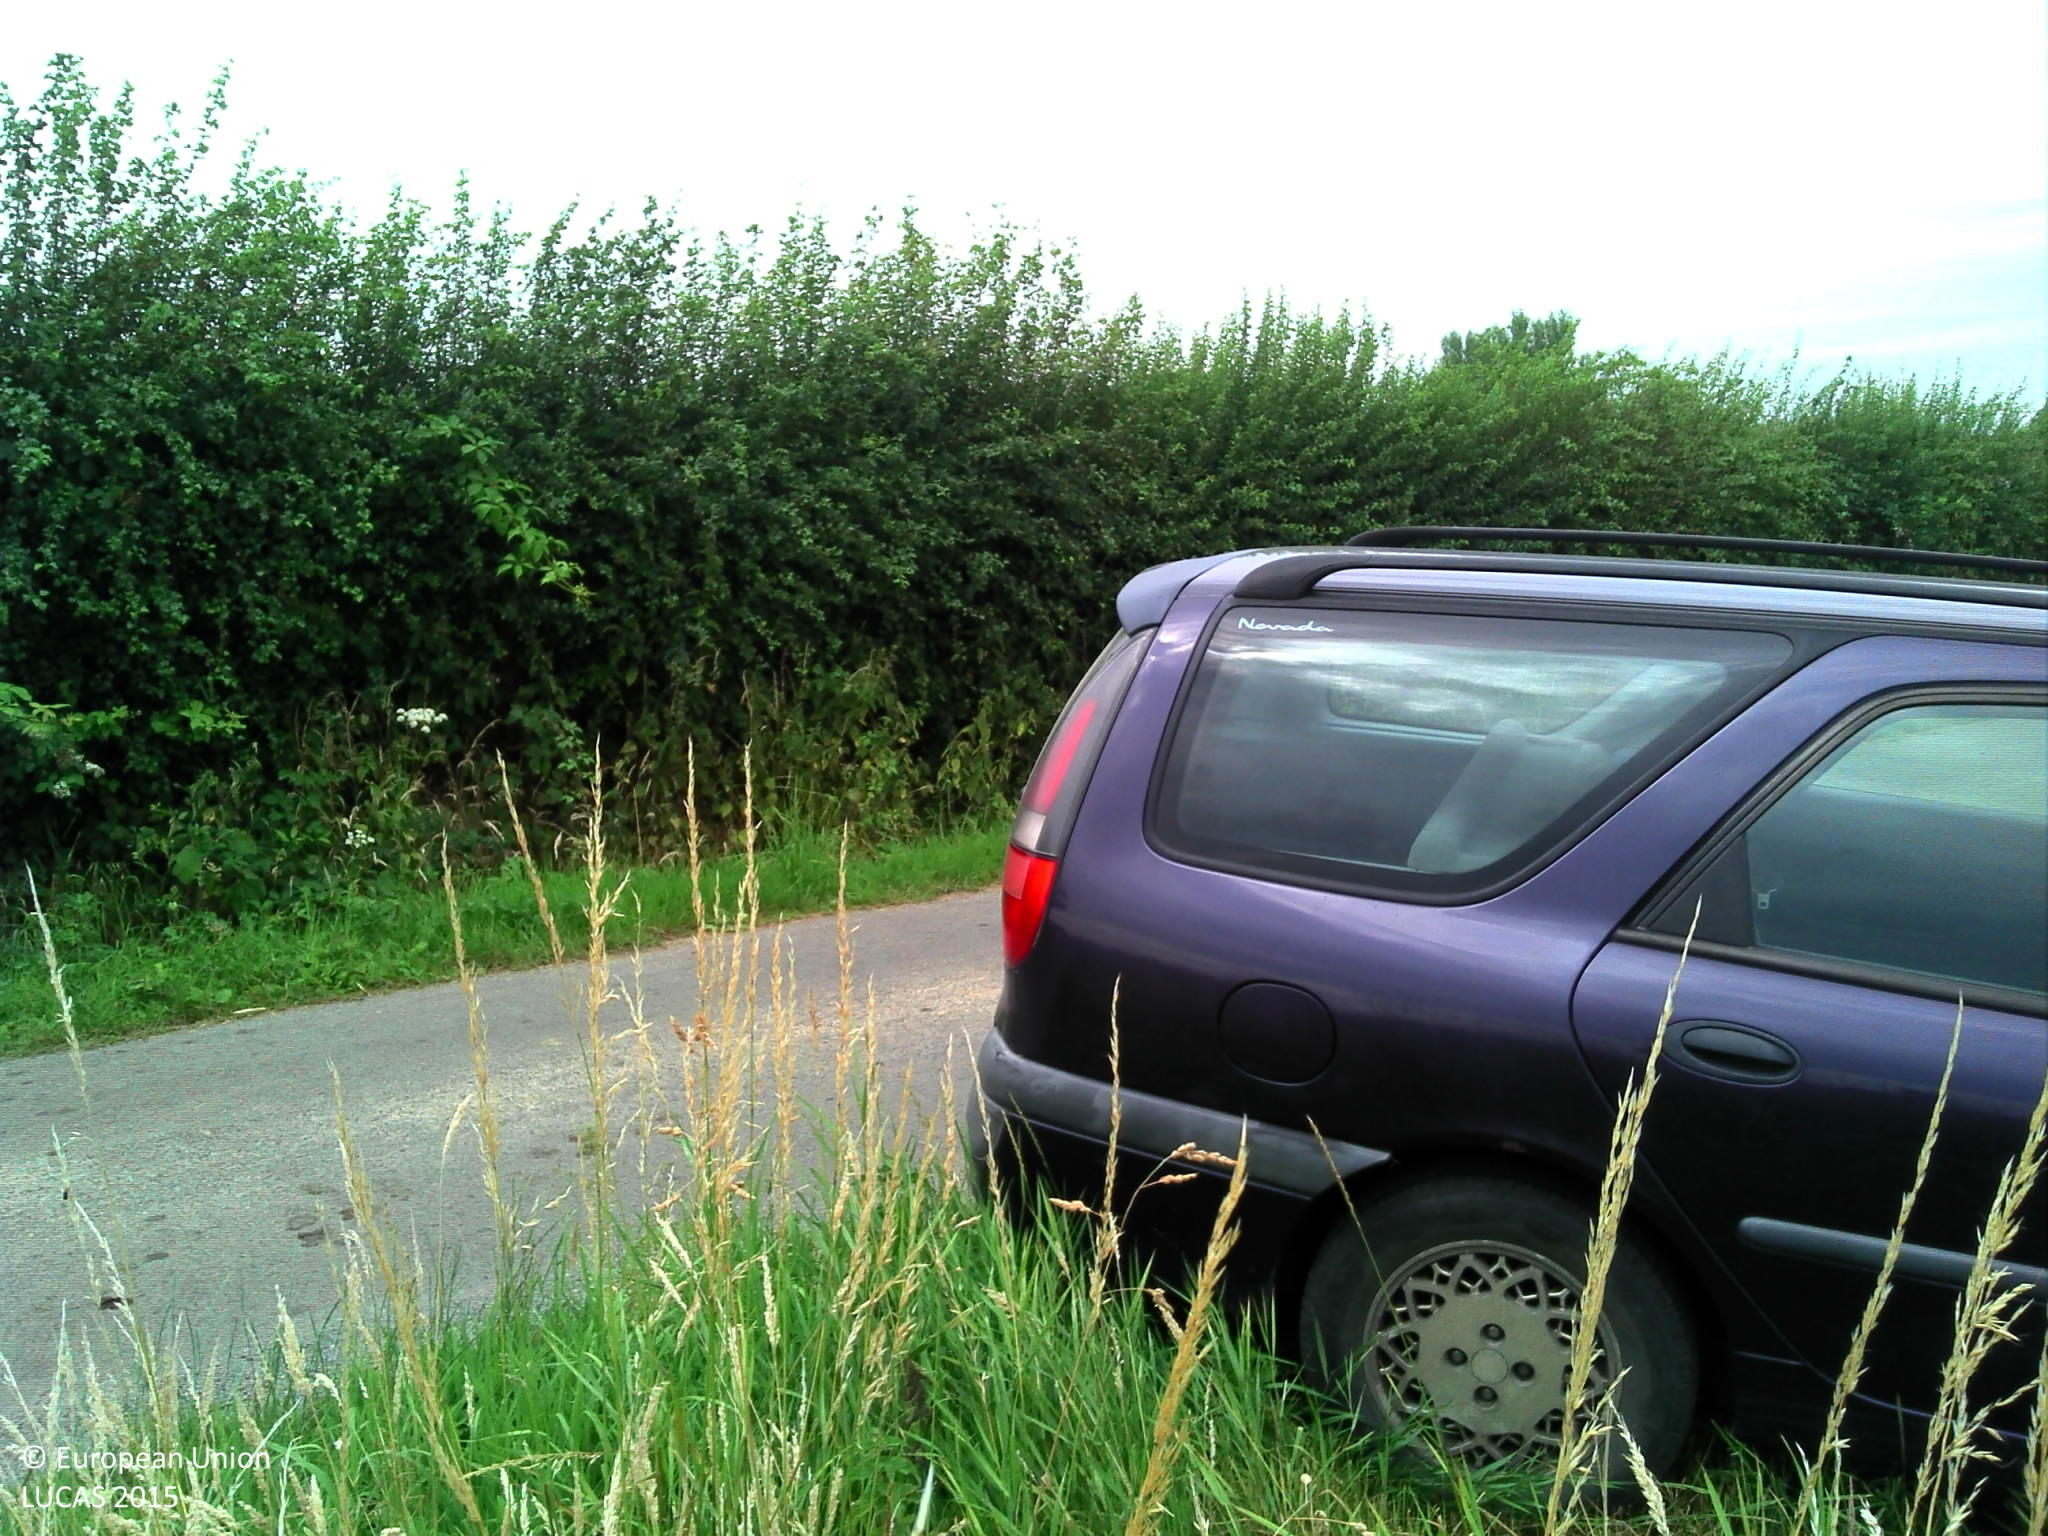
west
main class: Grassland
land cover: Grassland without tree/shrub cover
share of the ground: > 75 %
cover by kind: herbaceous plants 100 %
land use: Agriculture (excluding fallow land and kitchen gardens)
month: July
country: FR
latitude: 50.7993
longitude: 2.7097
